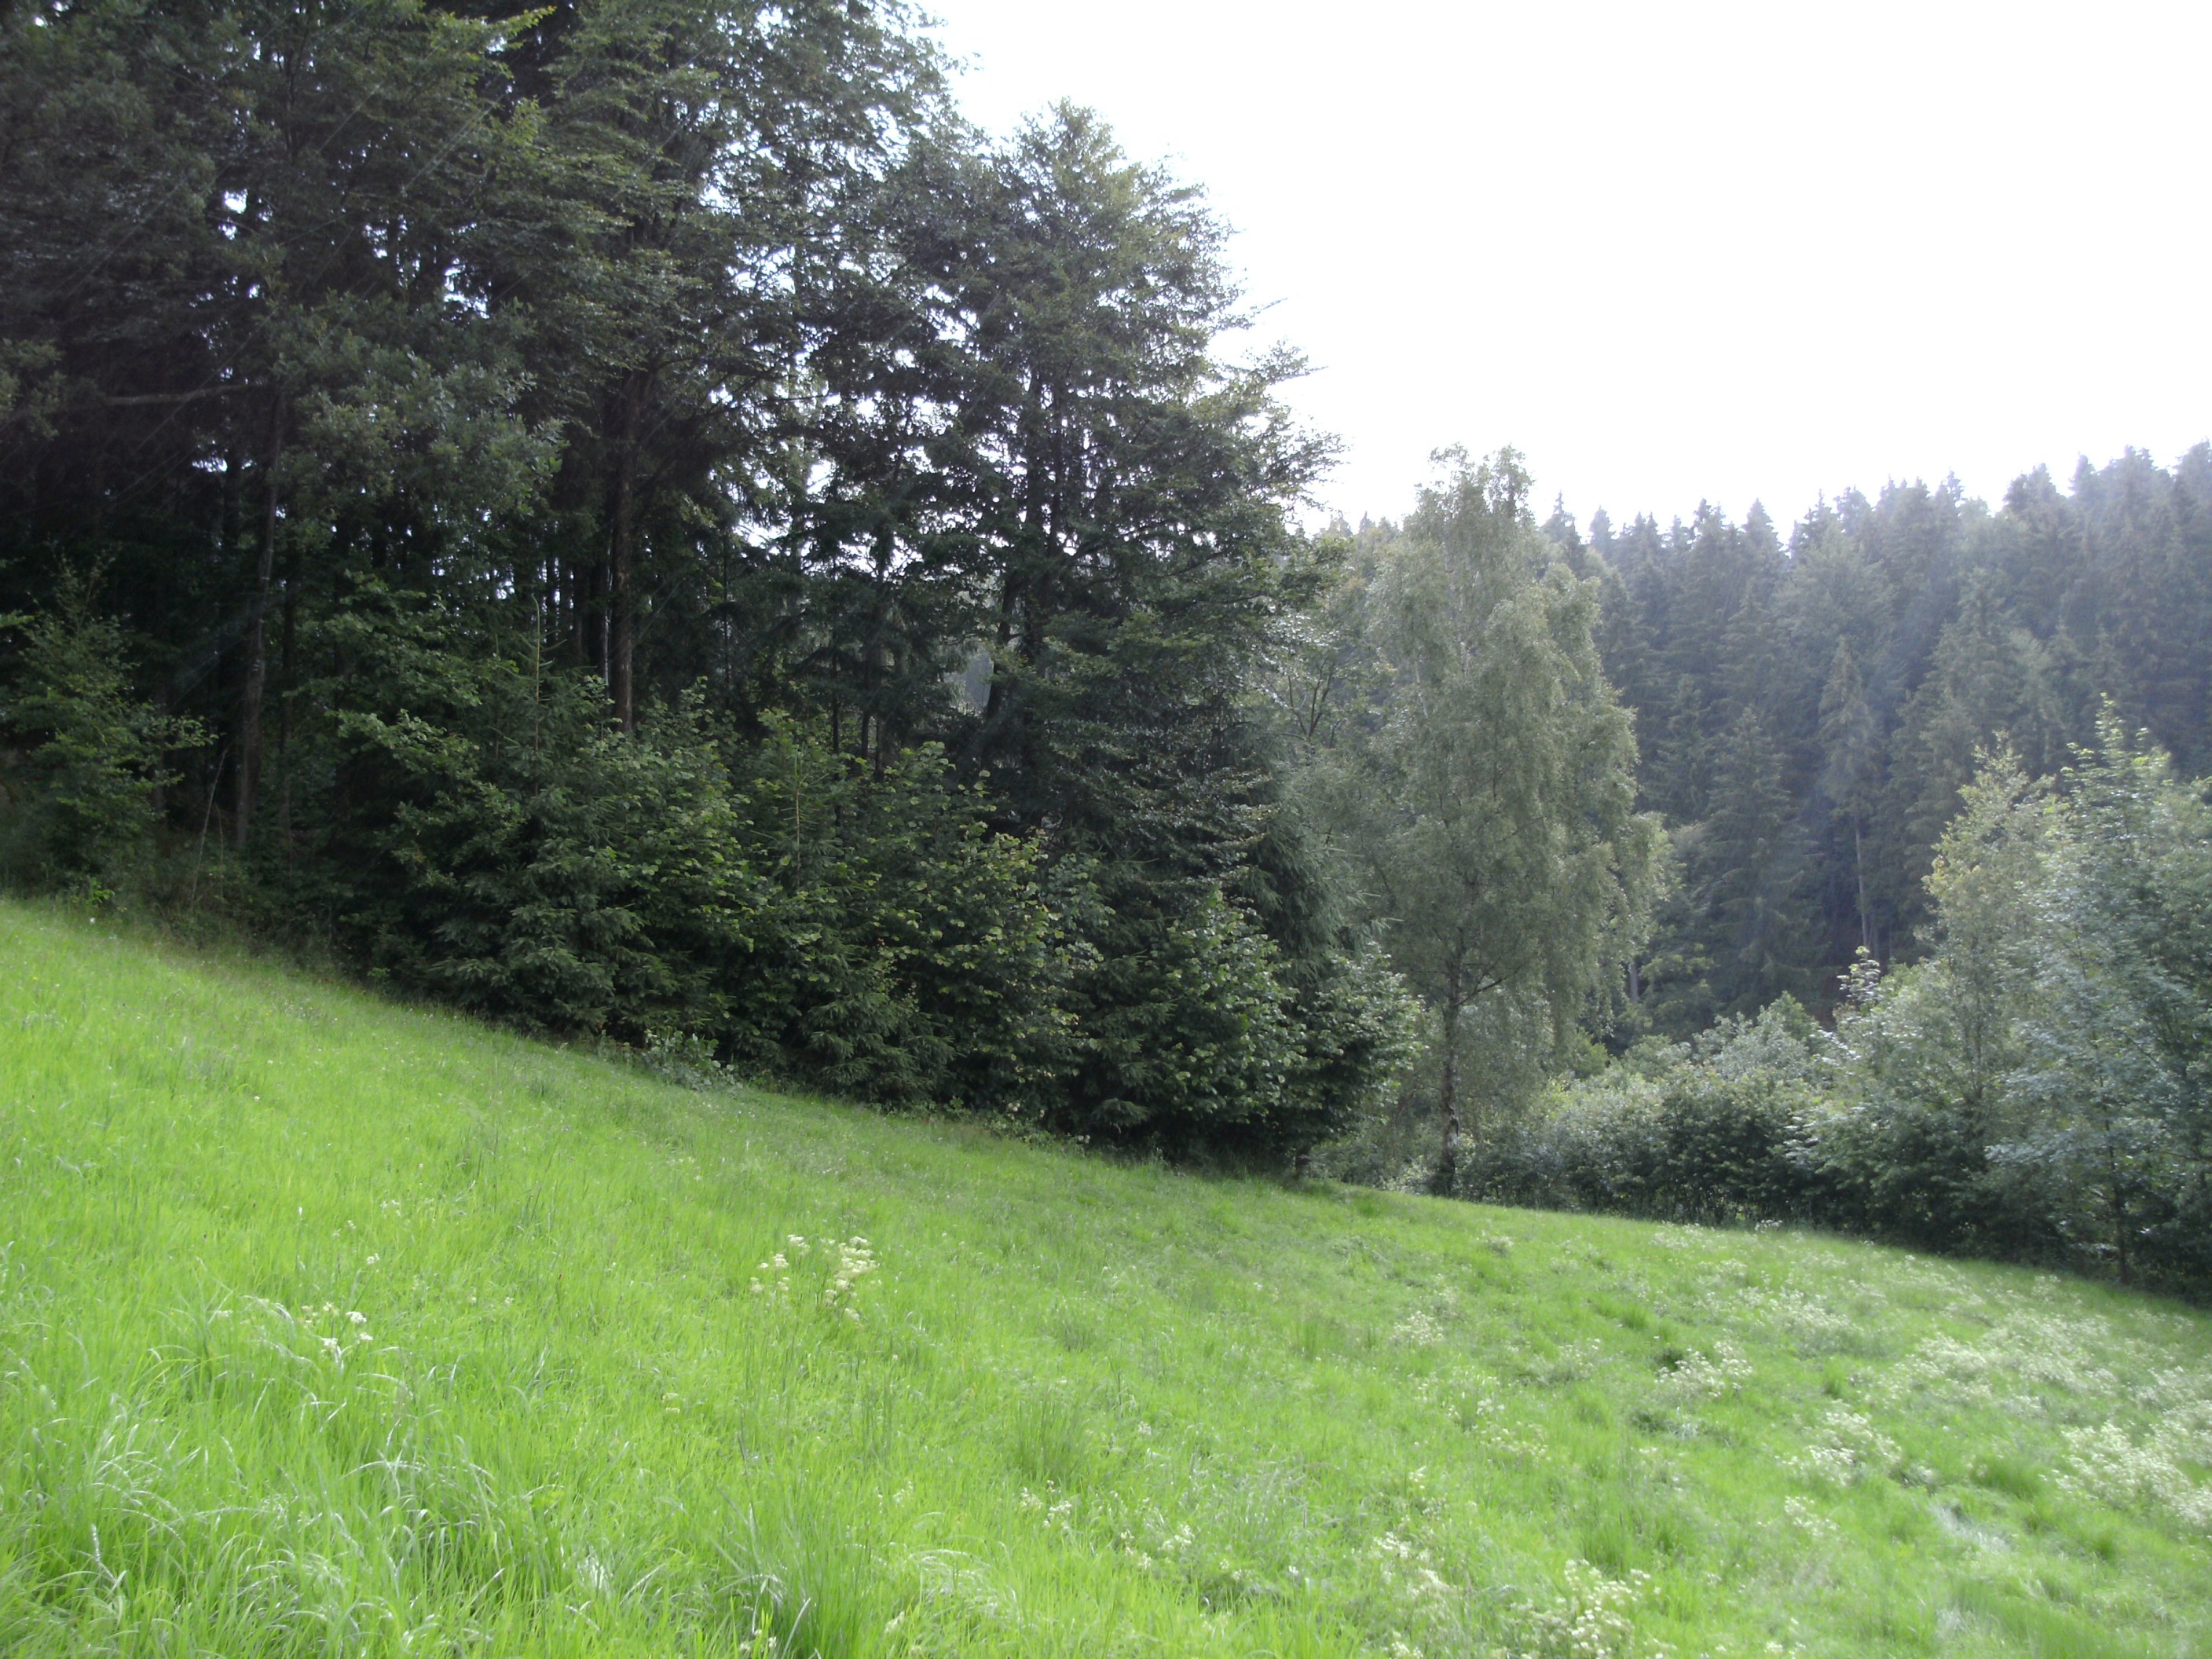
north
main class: Grassland
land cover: Grassland without tree/shrub cover
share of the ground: > 75 %
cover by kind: herbaceous plants 100 %
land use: Agriculture (excluding fallow land and kitchen gardens)
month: June
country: AT
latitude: 48.5523
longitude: 13.8610
